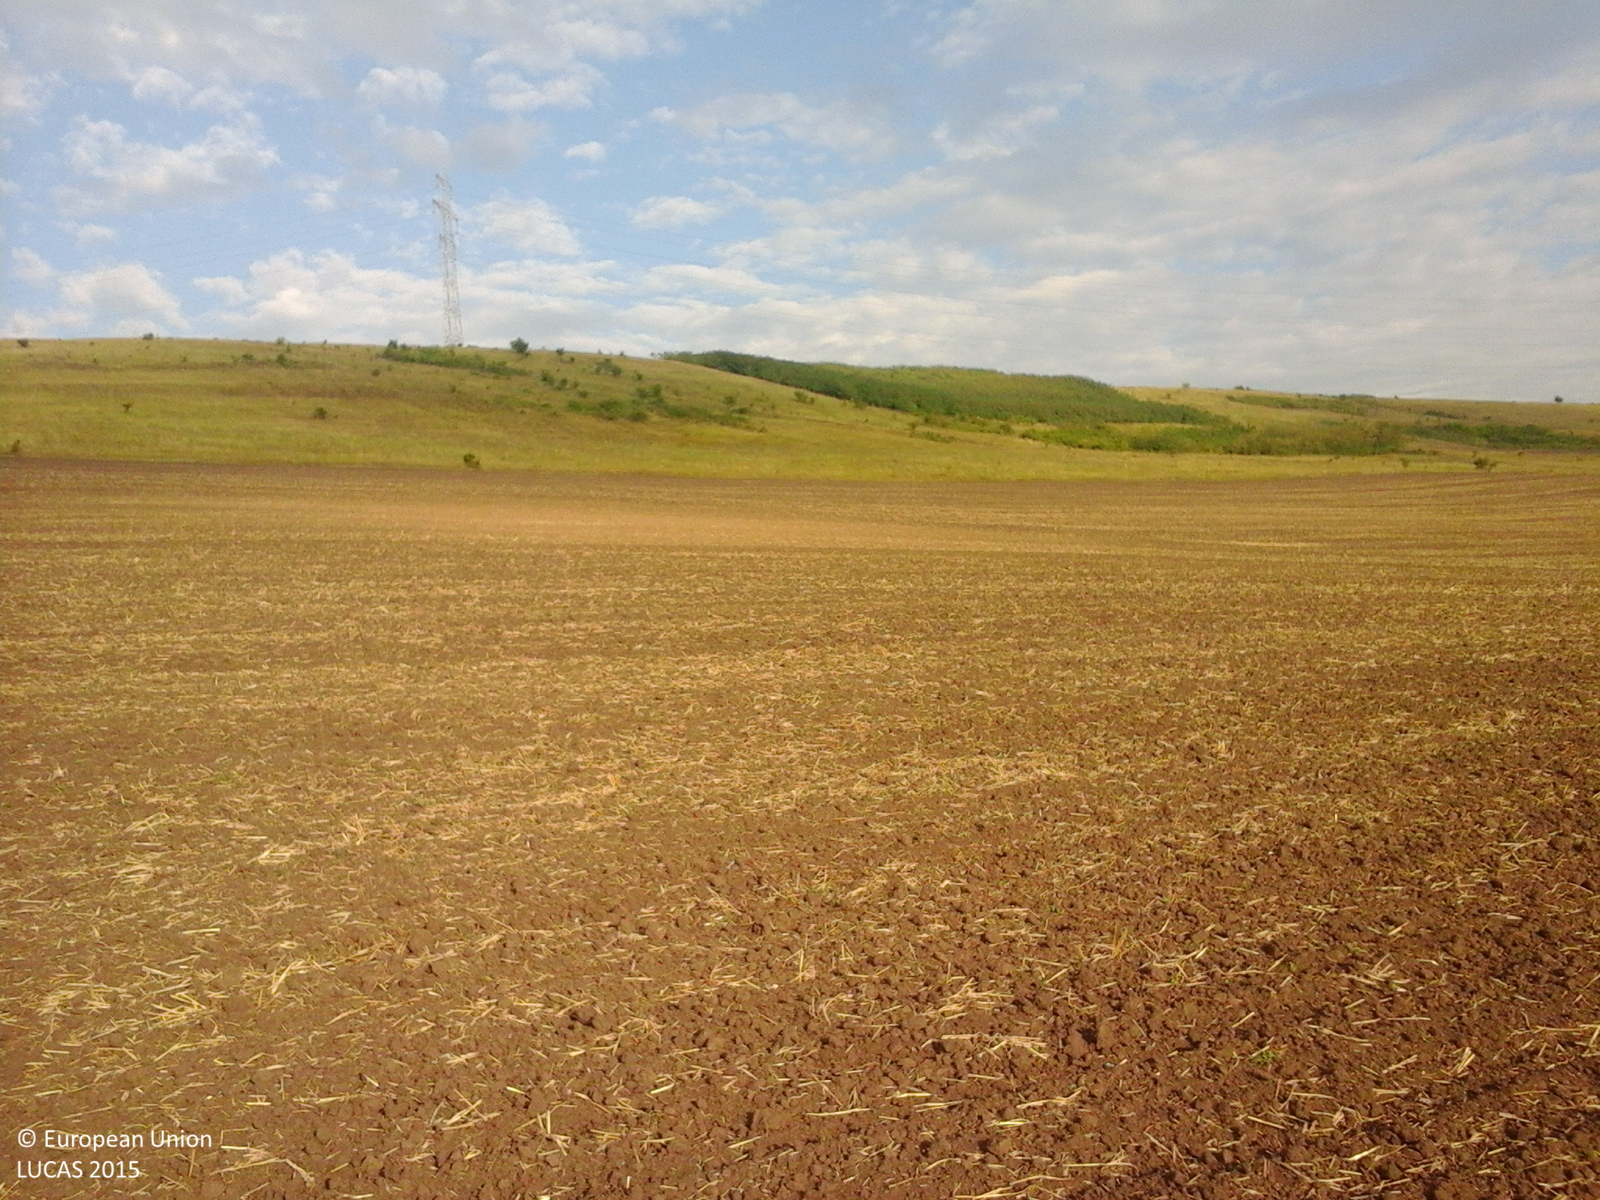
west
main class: Cropland
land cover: Durum wheat
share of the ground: > 75 %
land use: Agriculture (excluding fallow land and kitchen gardens)
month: July
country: RO
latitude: 46.4092
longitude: 27.7980
